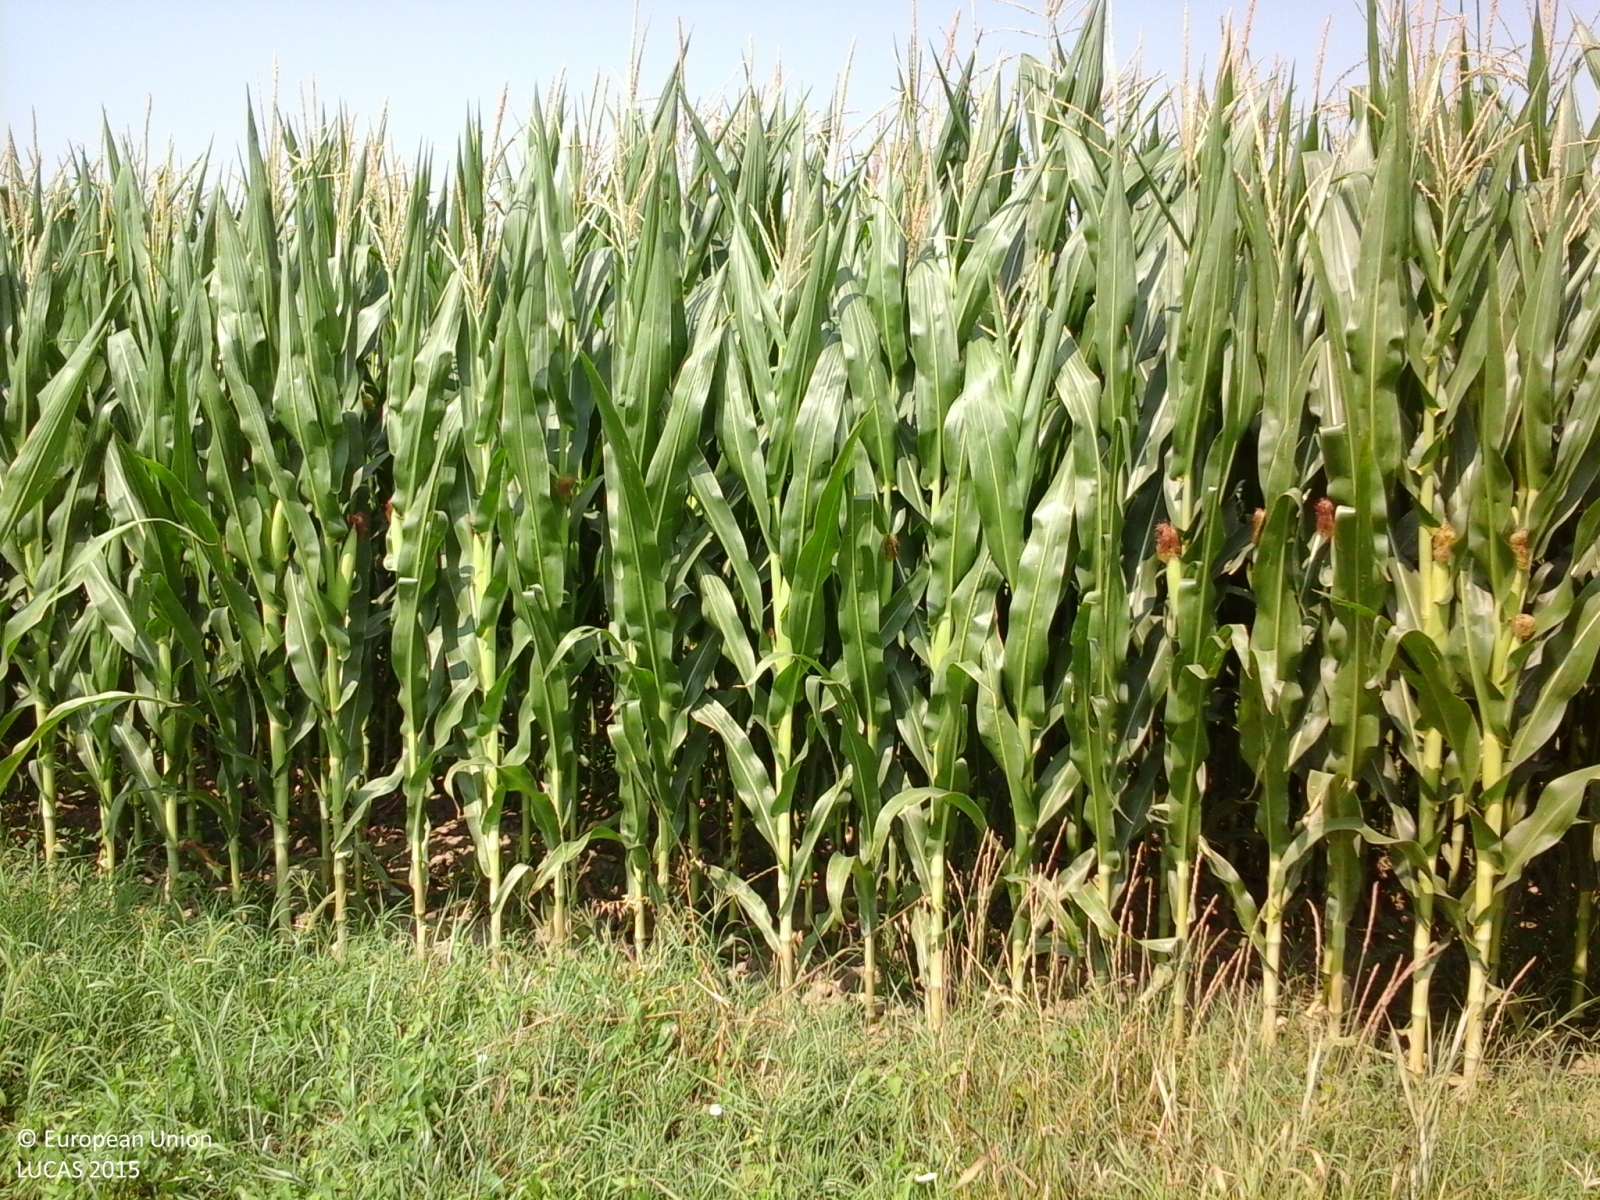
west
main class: Cropland
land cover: Maize
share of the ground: > 75 %
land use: Agriculture (excluding fallow land and kitchen gardens)
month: July
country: IT
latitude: 44.5900
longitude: 11.6467
